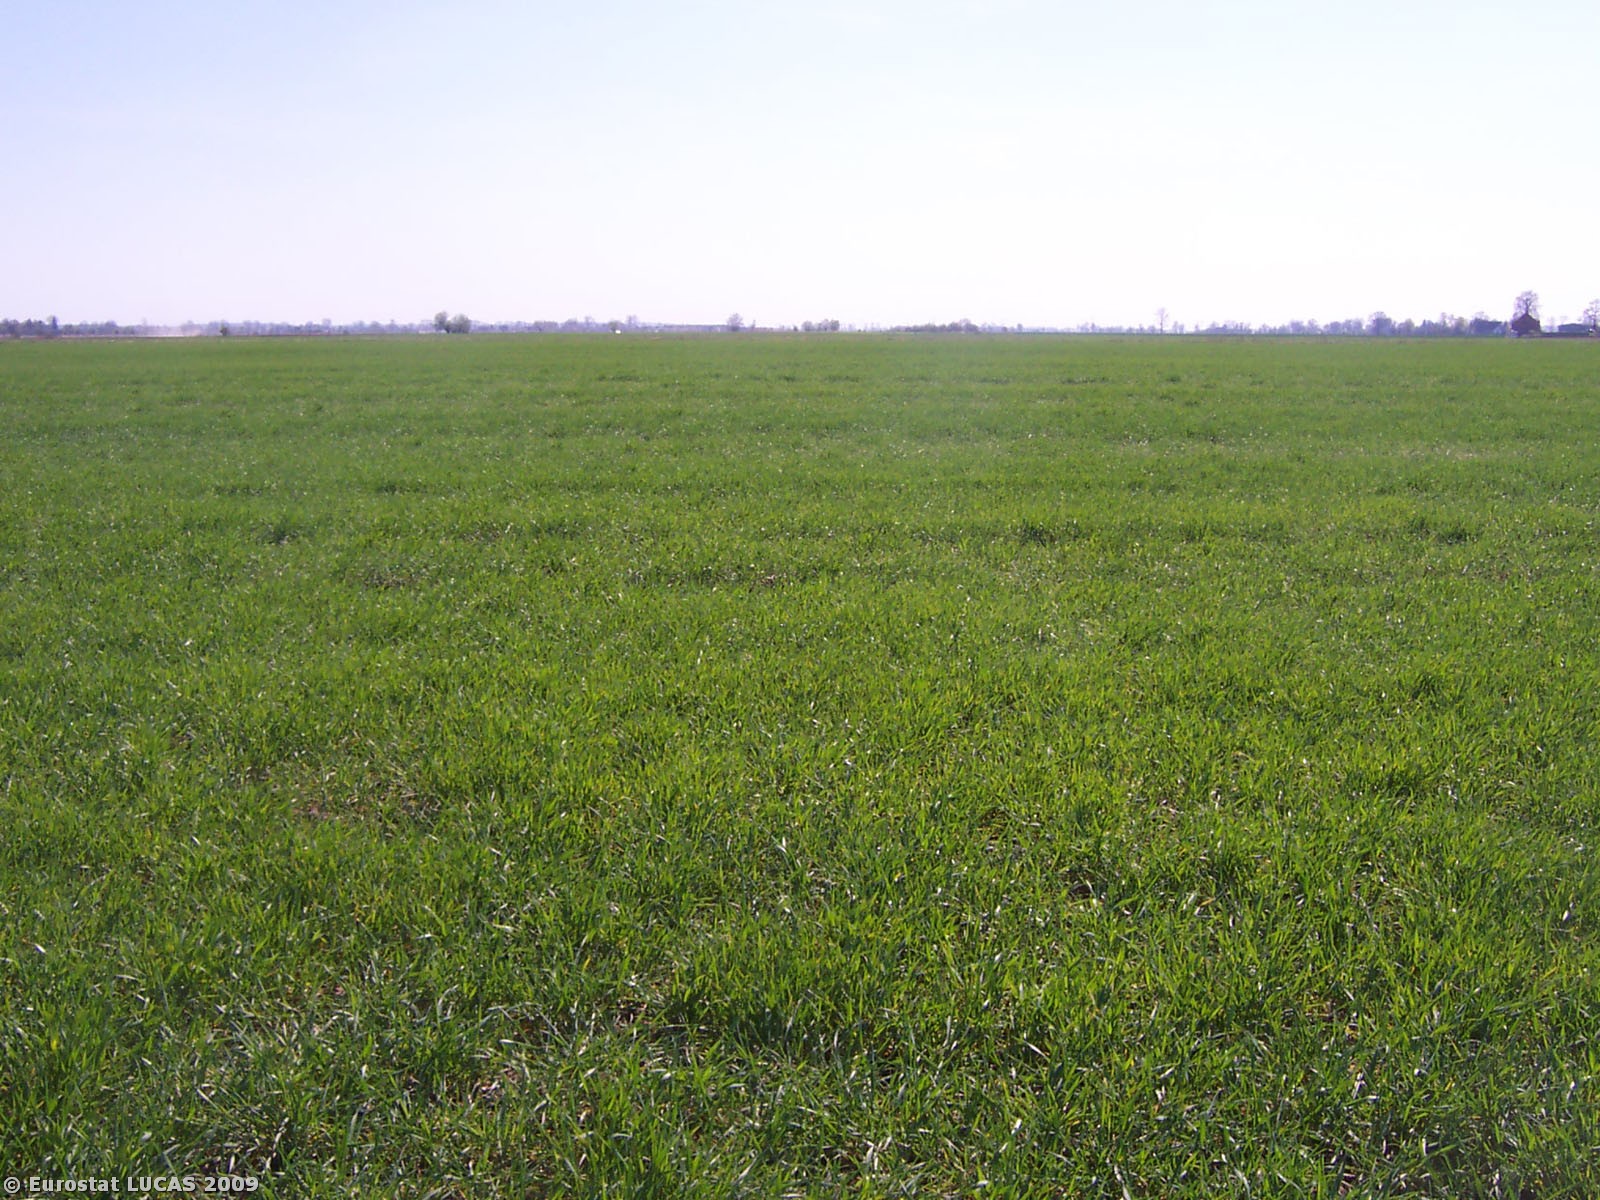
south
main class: Cropland
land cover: Common wheat
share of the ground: 25 - 50 %
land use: Agriculture (excluding fallow land and kitchen gardens)
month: April
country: PL
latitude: 54.1000
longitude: 18.9672
